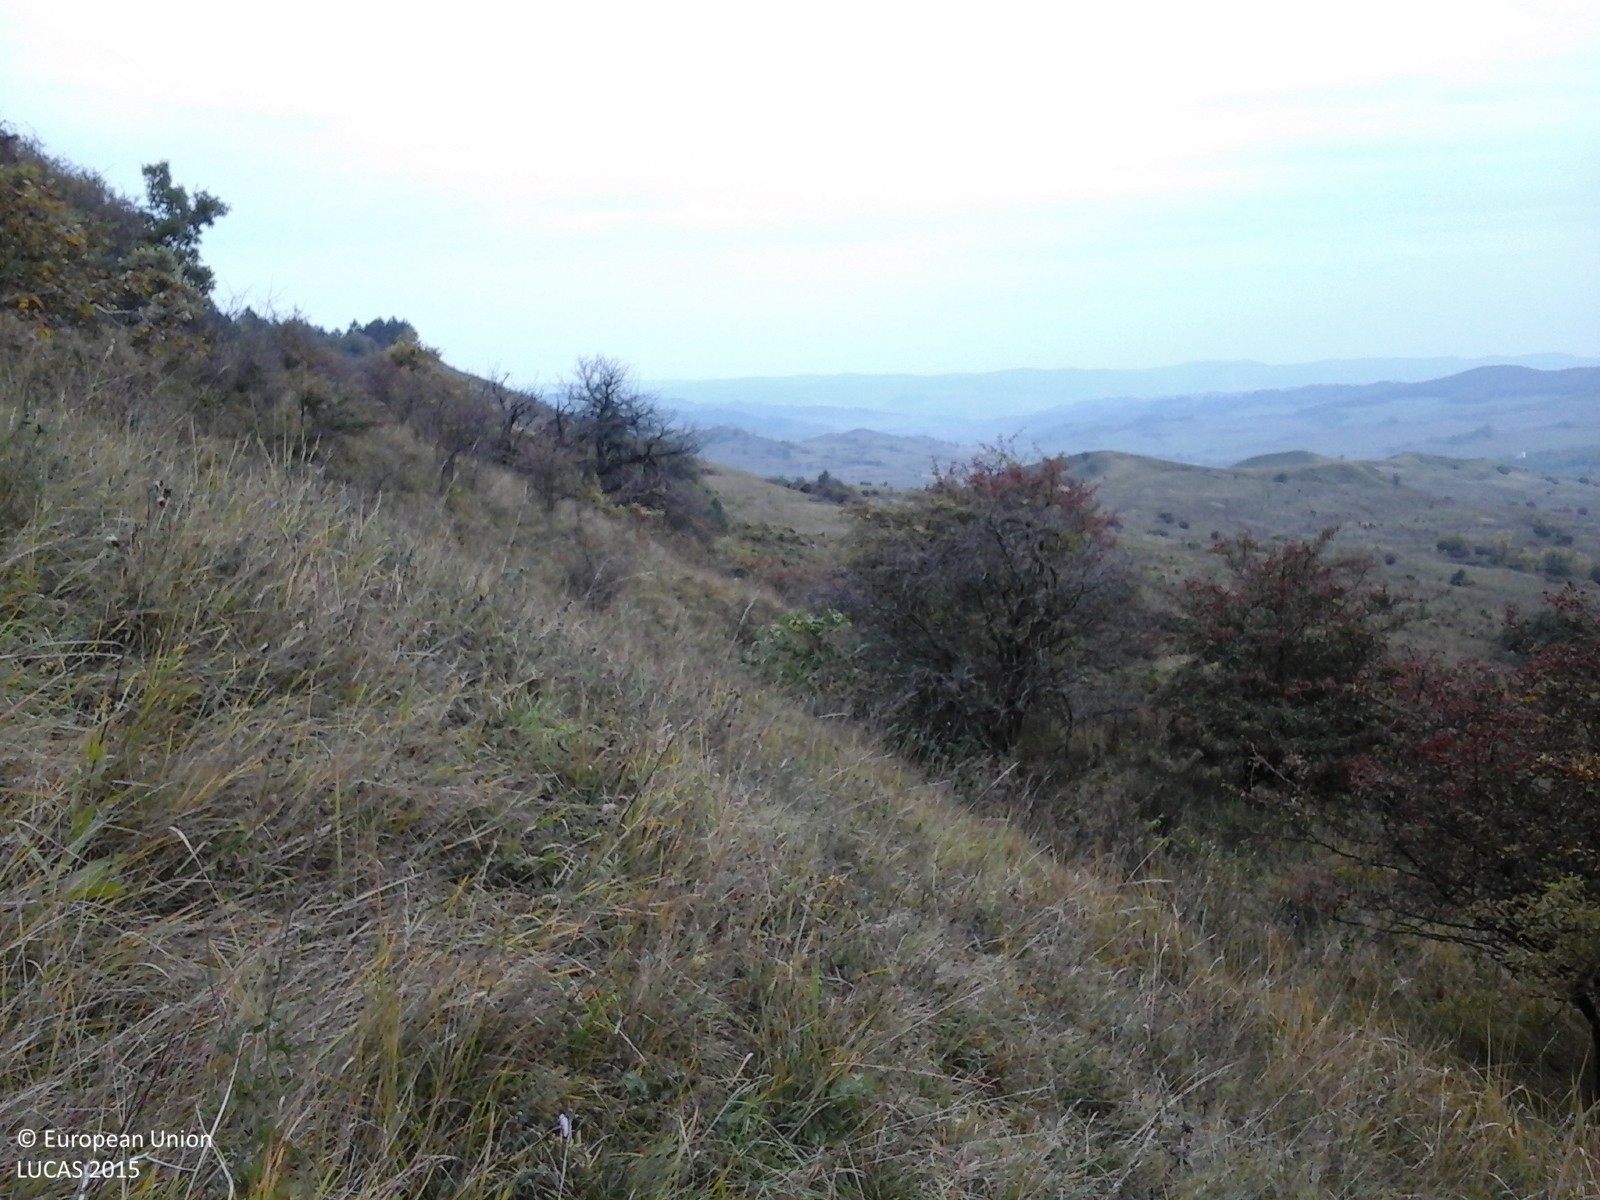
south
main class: Grassland
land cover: Grassland with sparse tree/shrub cover
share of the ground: > 75 %
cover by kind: herbaceous plants 85 %, shrubs 10 %, broadleaved forest trees 5 %
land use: Agriculture (excluding fallow land and kitchen gardens)
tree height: < 5 m
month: October
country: RO
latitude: 46.3373
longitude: 24.9444
